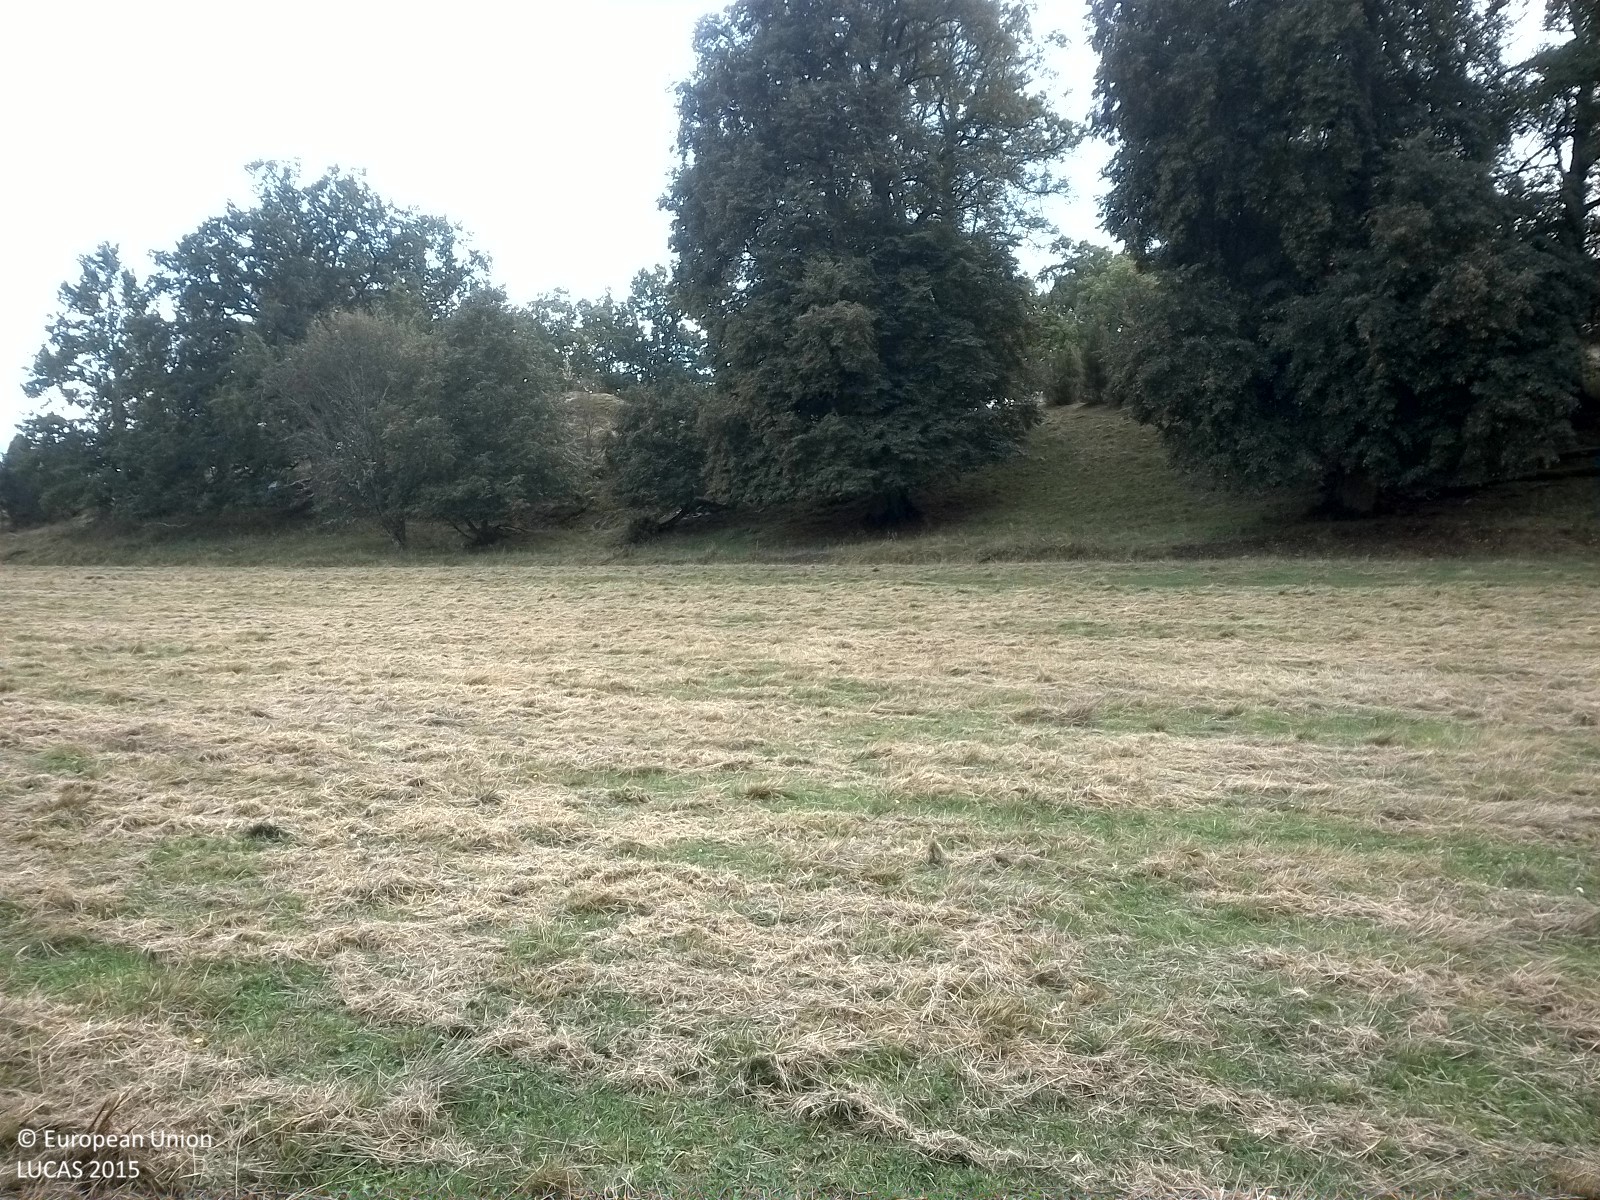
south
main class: Grassland
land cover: Grassland without tree/shrub cover
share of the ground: > 75 %
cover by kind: herbaceous plants 100 %
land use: Agriculture (excluding fallow land and kitchen gardens)
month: September
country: SE
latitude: 58.5930
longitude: 16.7235
